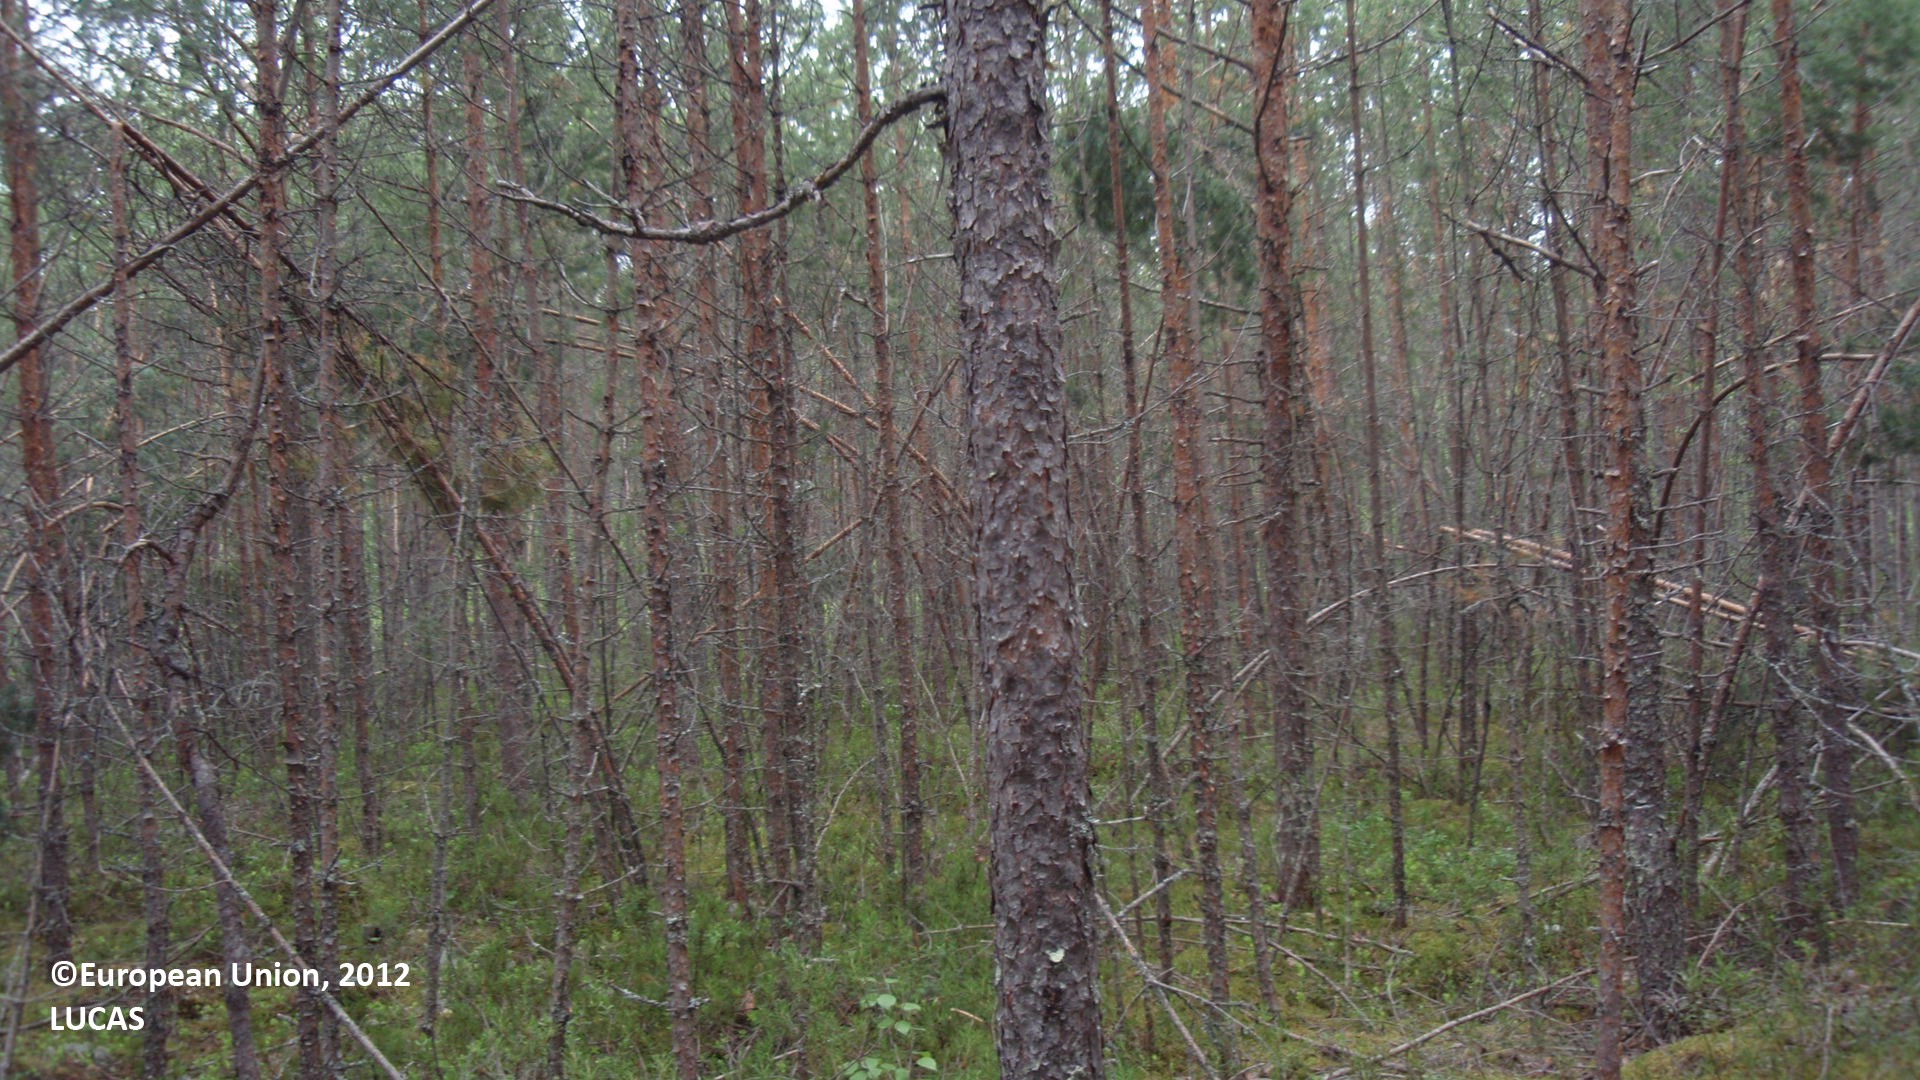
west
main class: Woodland
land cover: Pine dominated coniferous woodland
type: boreal forest
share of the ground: > 75 %
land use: Forestry
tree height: > 5 m
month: June
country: FI
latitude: 61.0891
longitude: 26.7542
